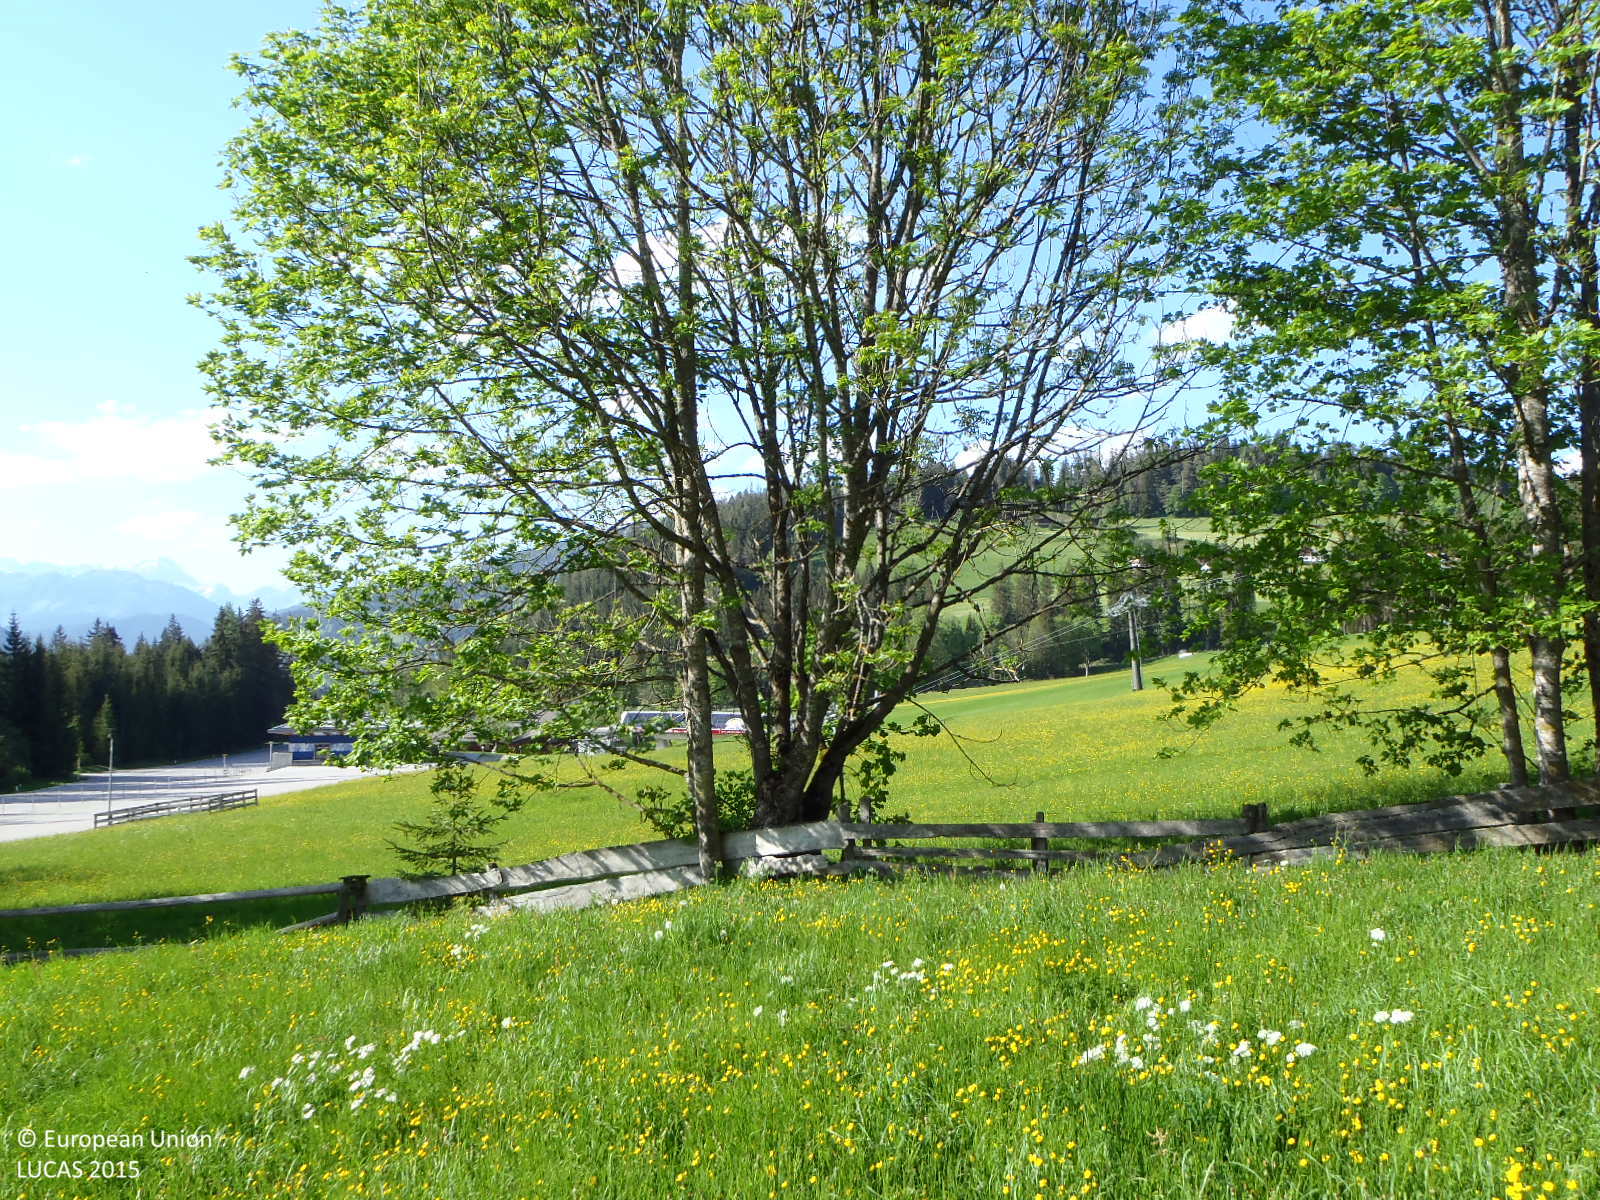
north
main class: Grassland
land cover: Grassland without tree/shrub cover
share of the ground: > 75 %
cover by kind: herbaceous plants 100 %
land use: Agriculture (excluding fallow land and kitchen gardens)
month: May
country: AT
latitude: 47.3597
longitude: 13.4274
